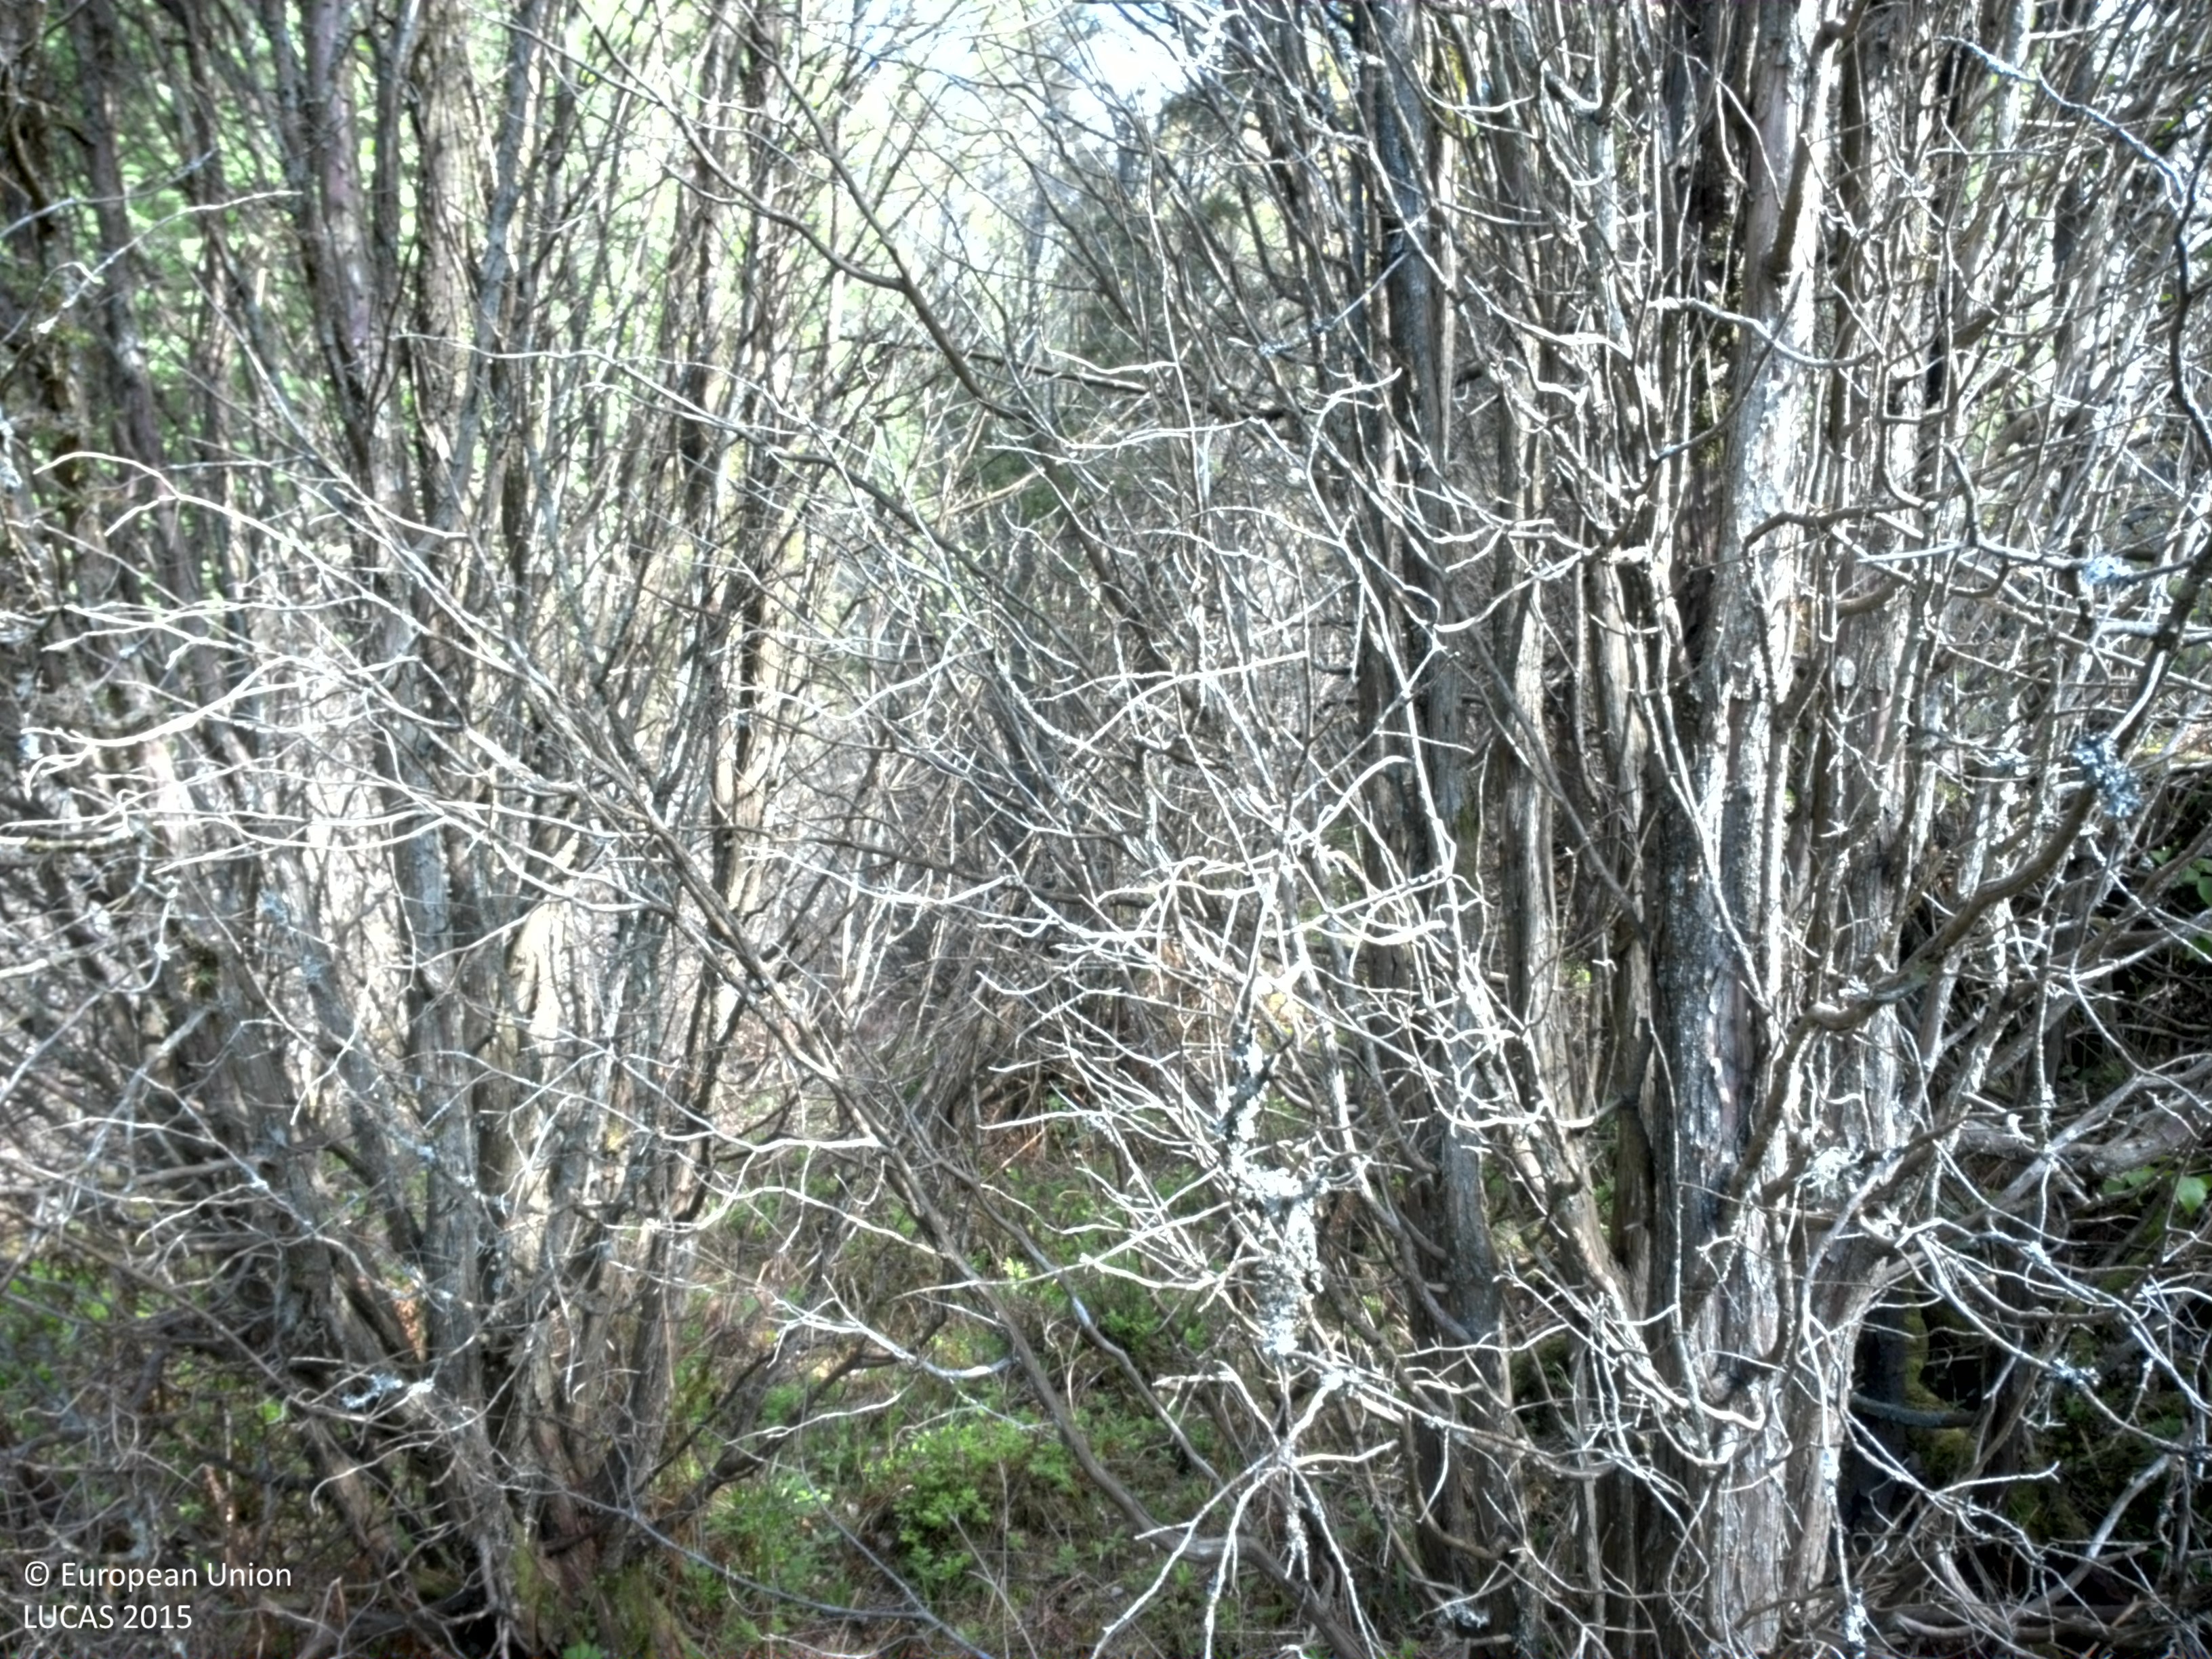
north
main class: Woodland
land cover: Pine dominated mixed woodland
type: boreal forest
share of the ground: 50 - 75 %
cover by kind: coniferous forest trees 50 %, broadleaved forest trees 25 %, shrubs 15 %, herbaceous plants 10 %
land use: Amenities, museums, leisure
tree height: > 5 m
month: May
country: SE
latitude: 57.6116
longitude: 11.9552
